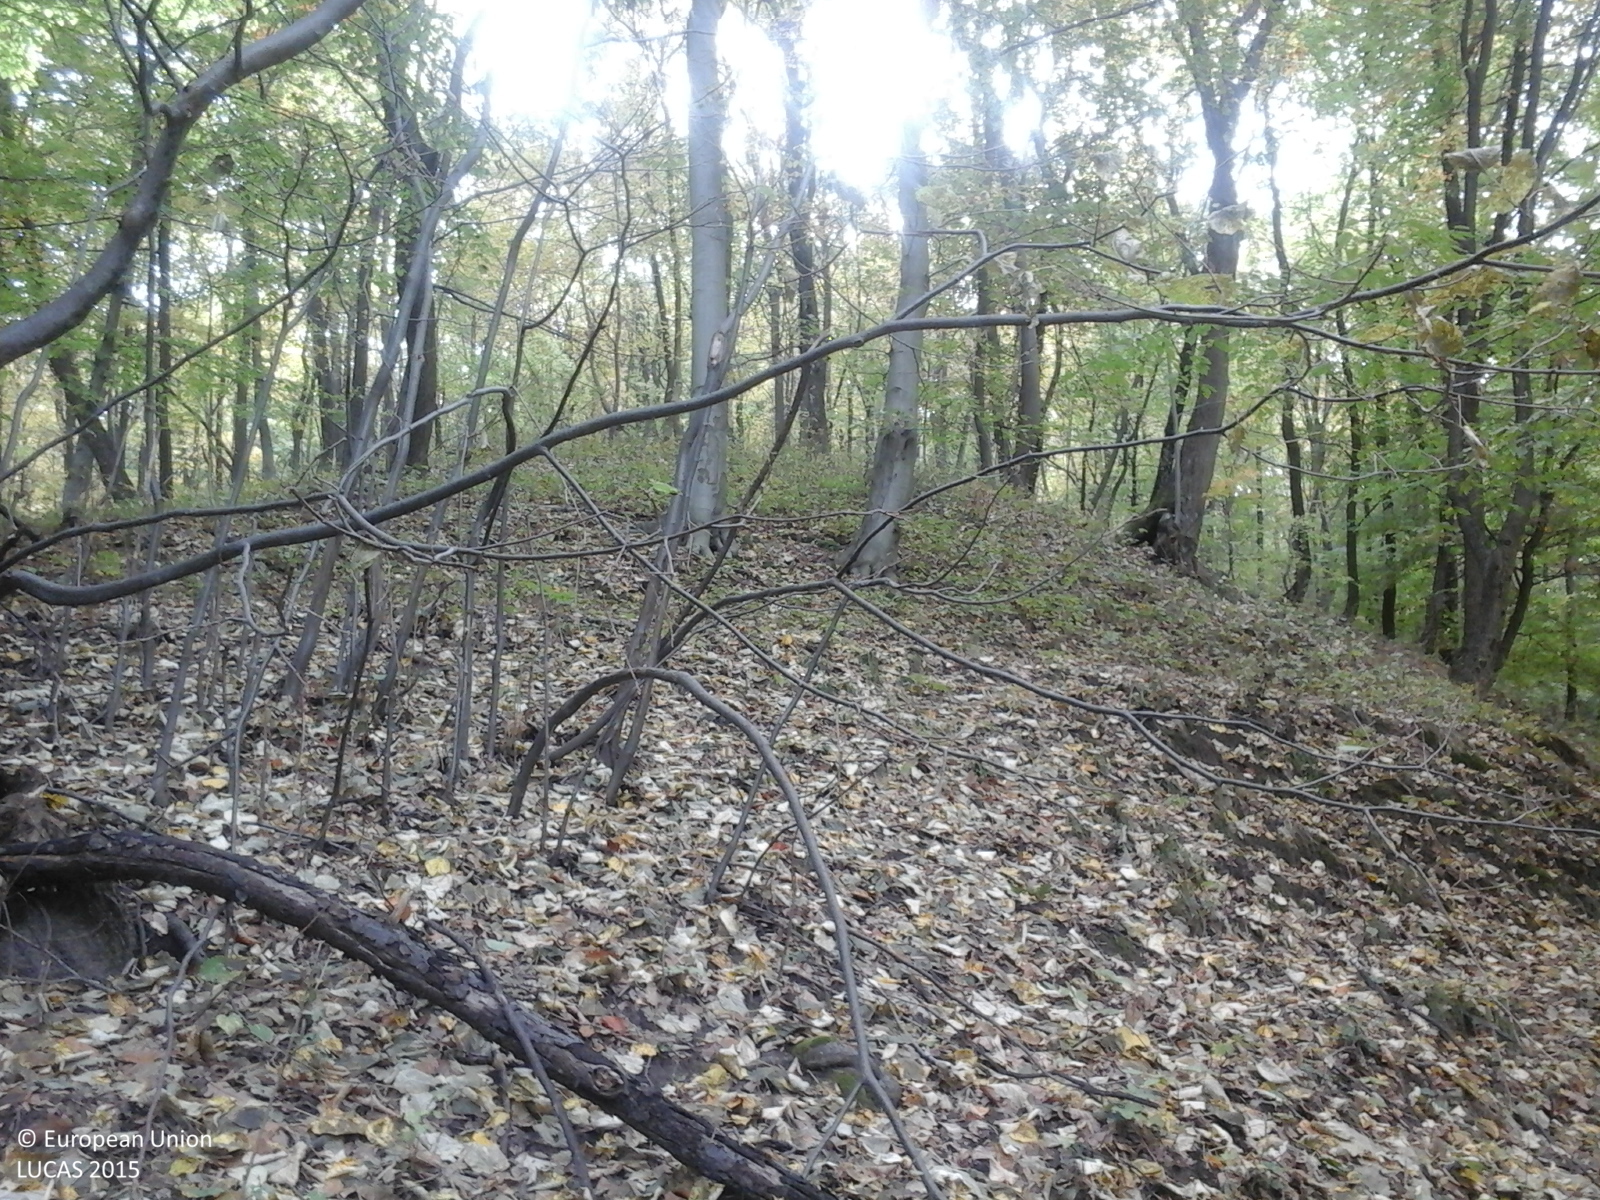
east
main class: Woodland
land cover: Broadleaved woodland
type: beech forest
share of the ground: > 75 %
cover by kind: broadleaved forest trees 100 %
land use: Forestry
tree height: > 5 m
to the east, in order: Broadleaved woodland
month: October
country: RO
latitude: 45.0389
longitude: 26.2754
